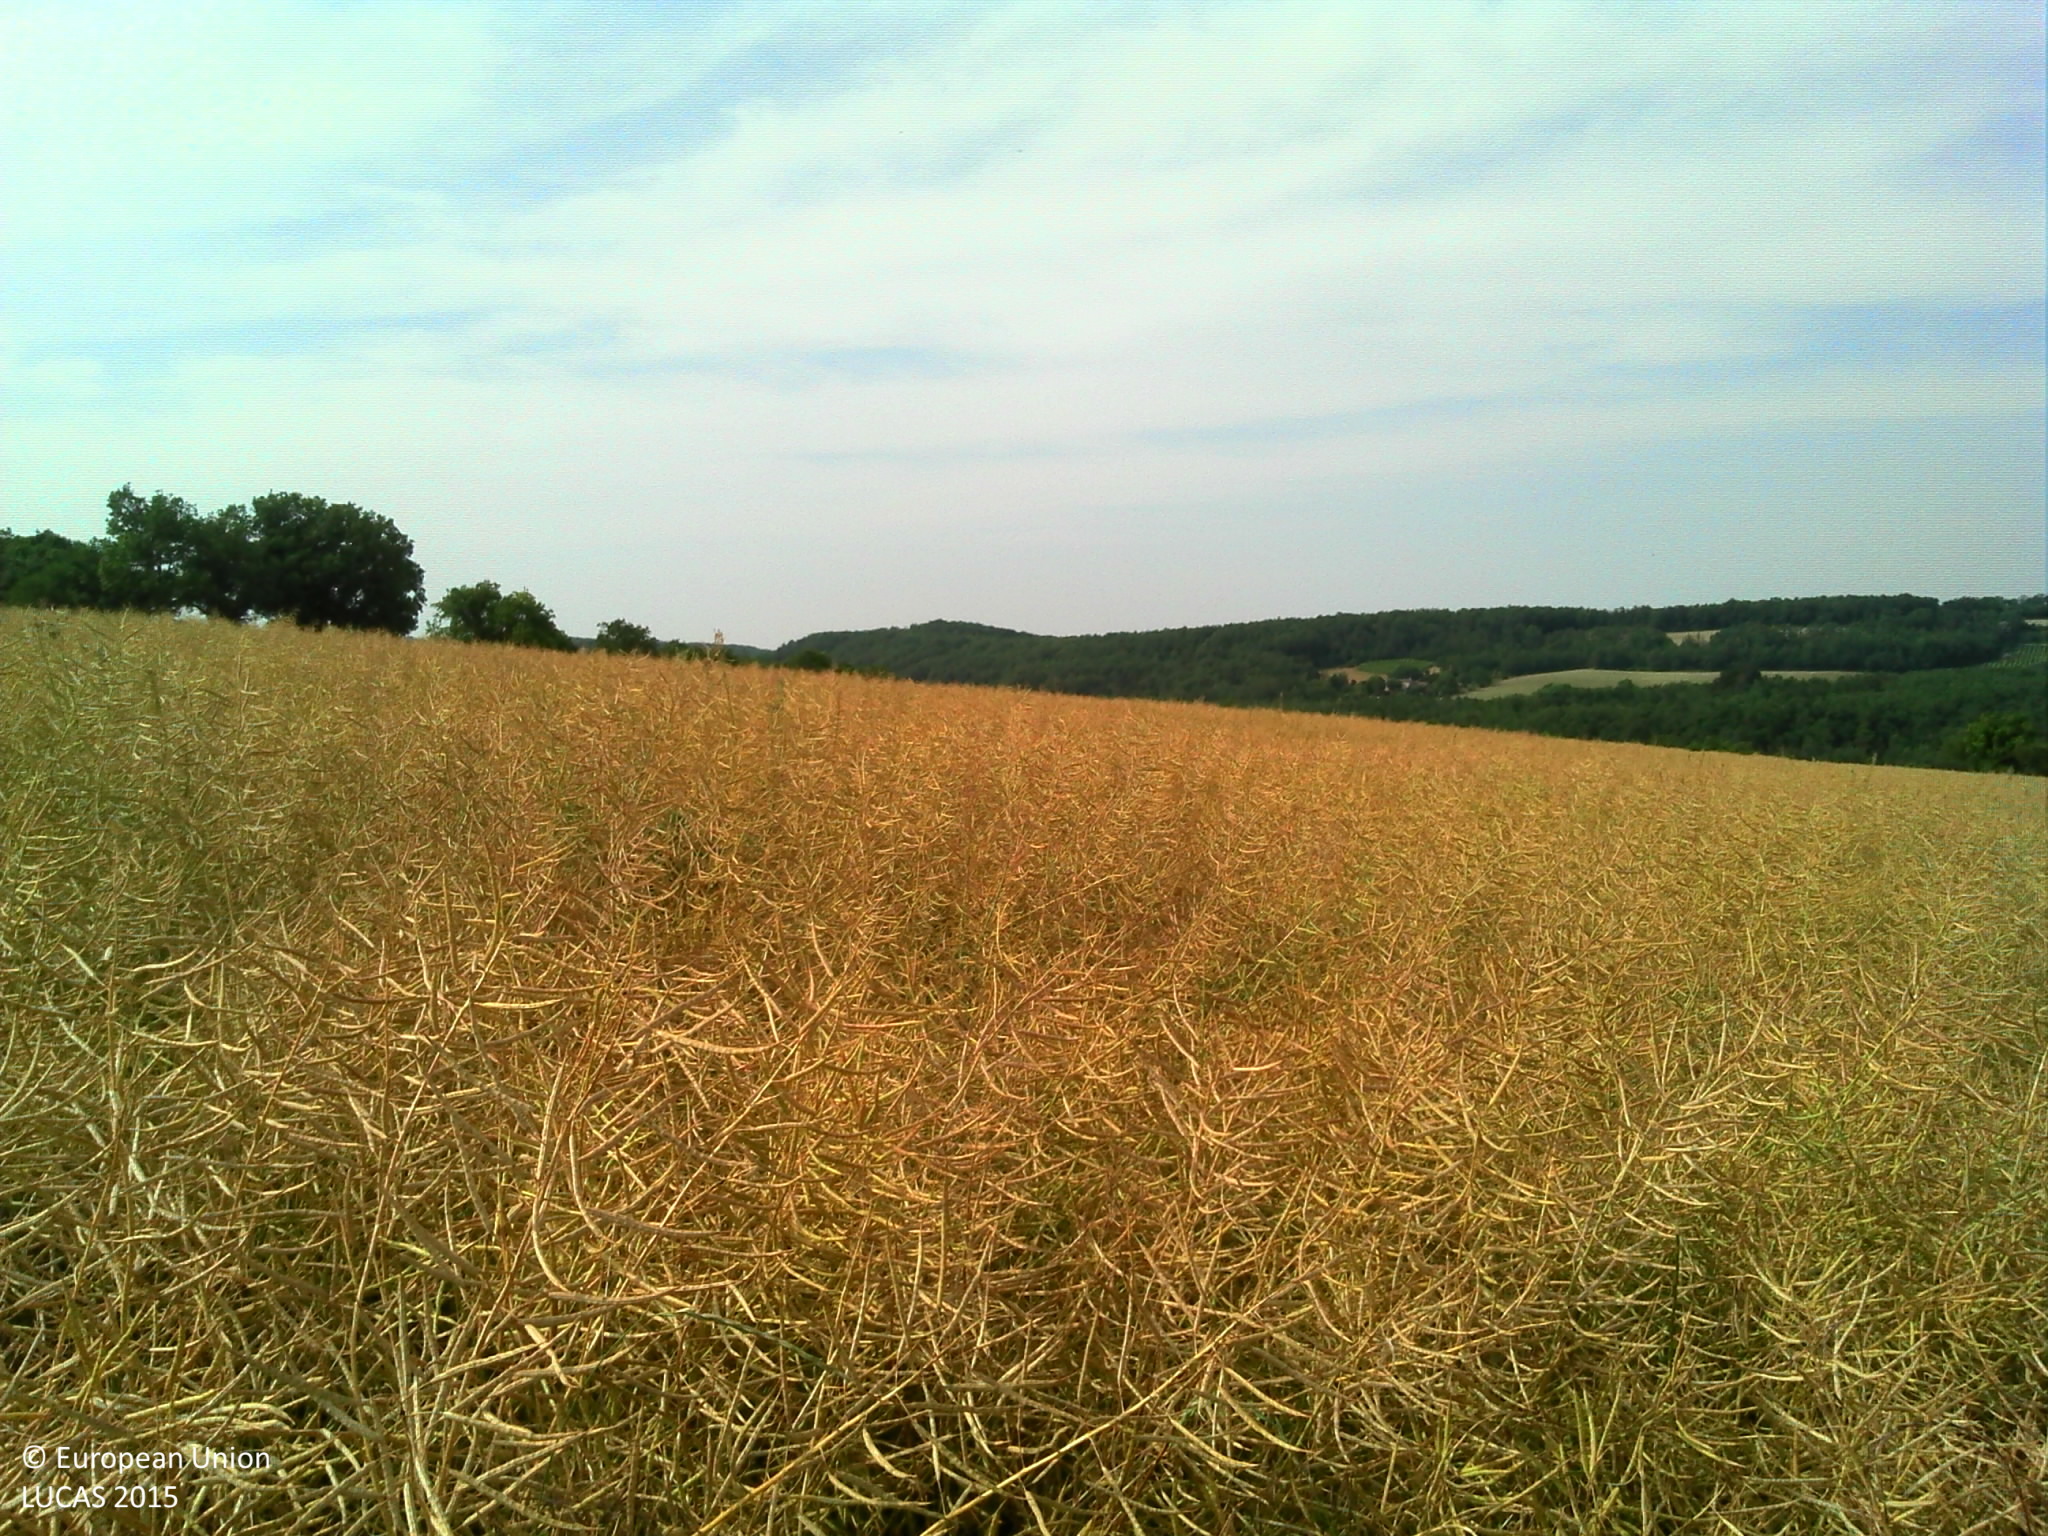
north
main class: Cropland
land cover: Rape and turnip rape
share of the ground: > 75 %
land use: Agriculture (excluding fallow land and kitchen gardens)
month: June
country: FR
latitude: 44.6792
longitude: 4.9476
